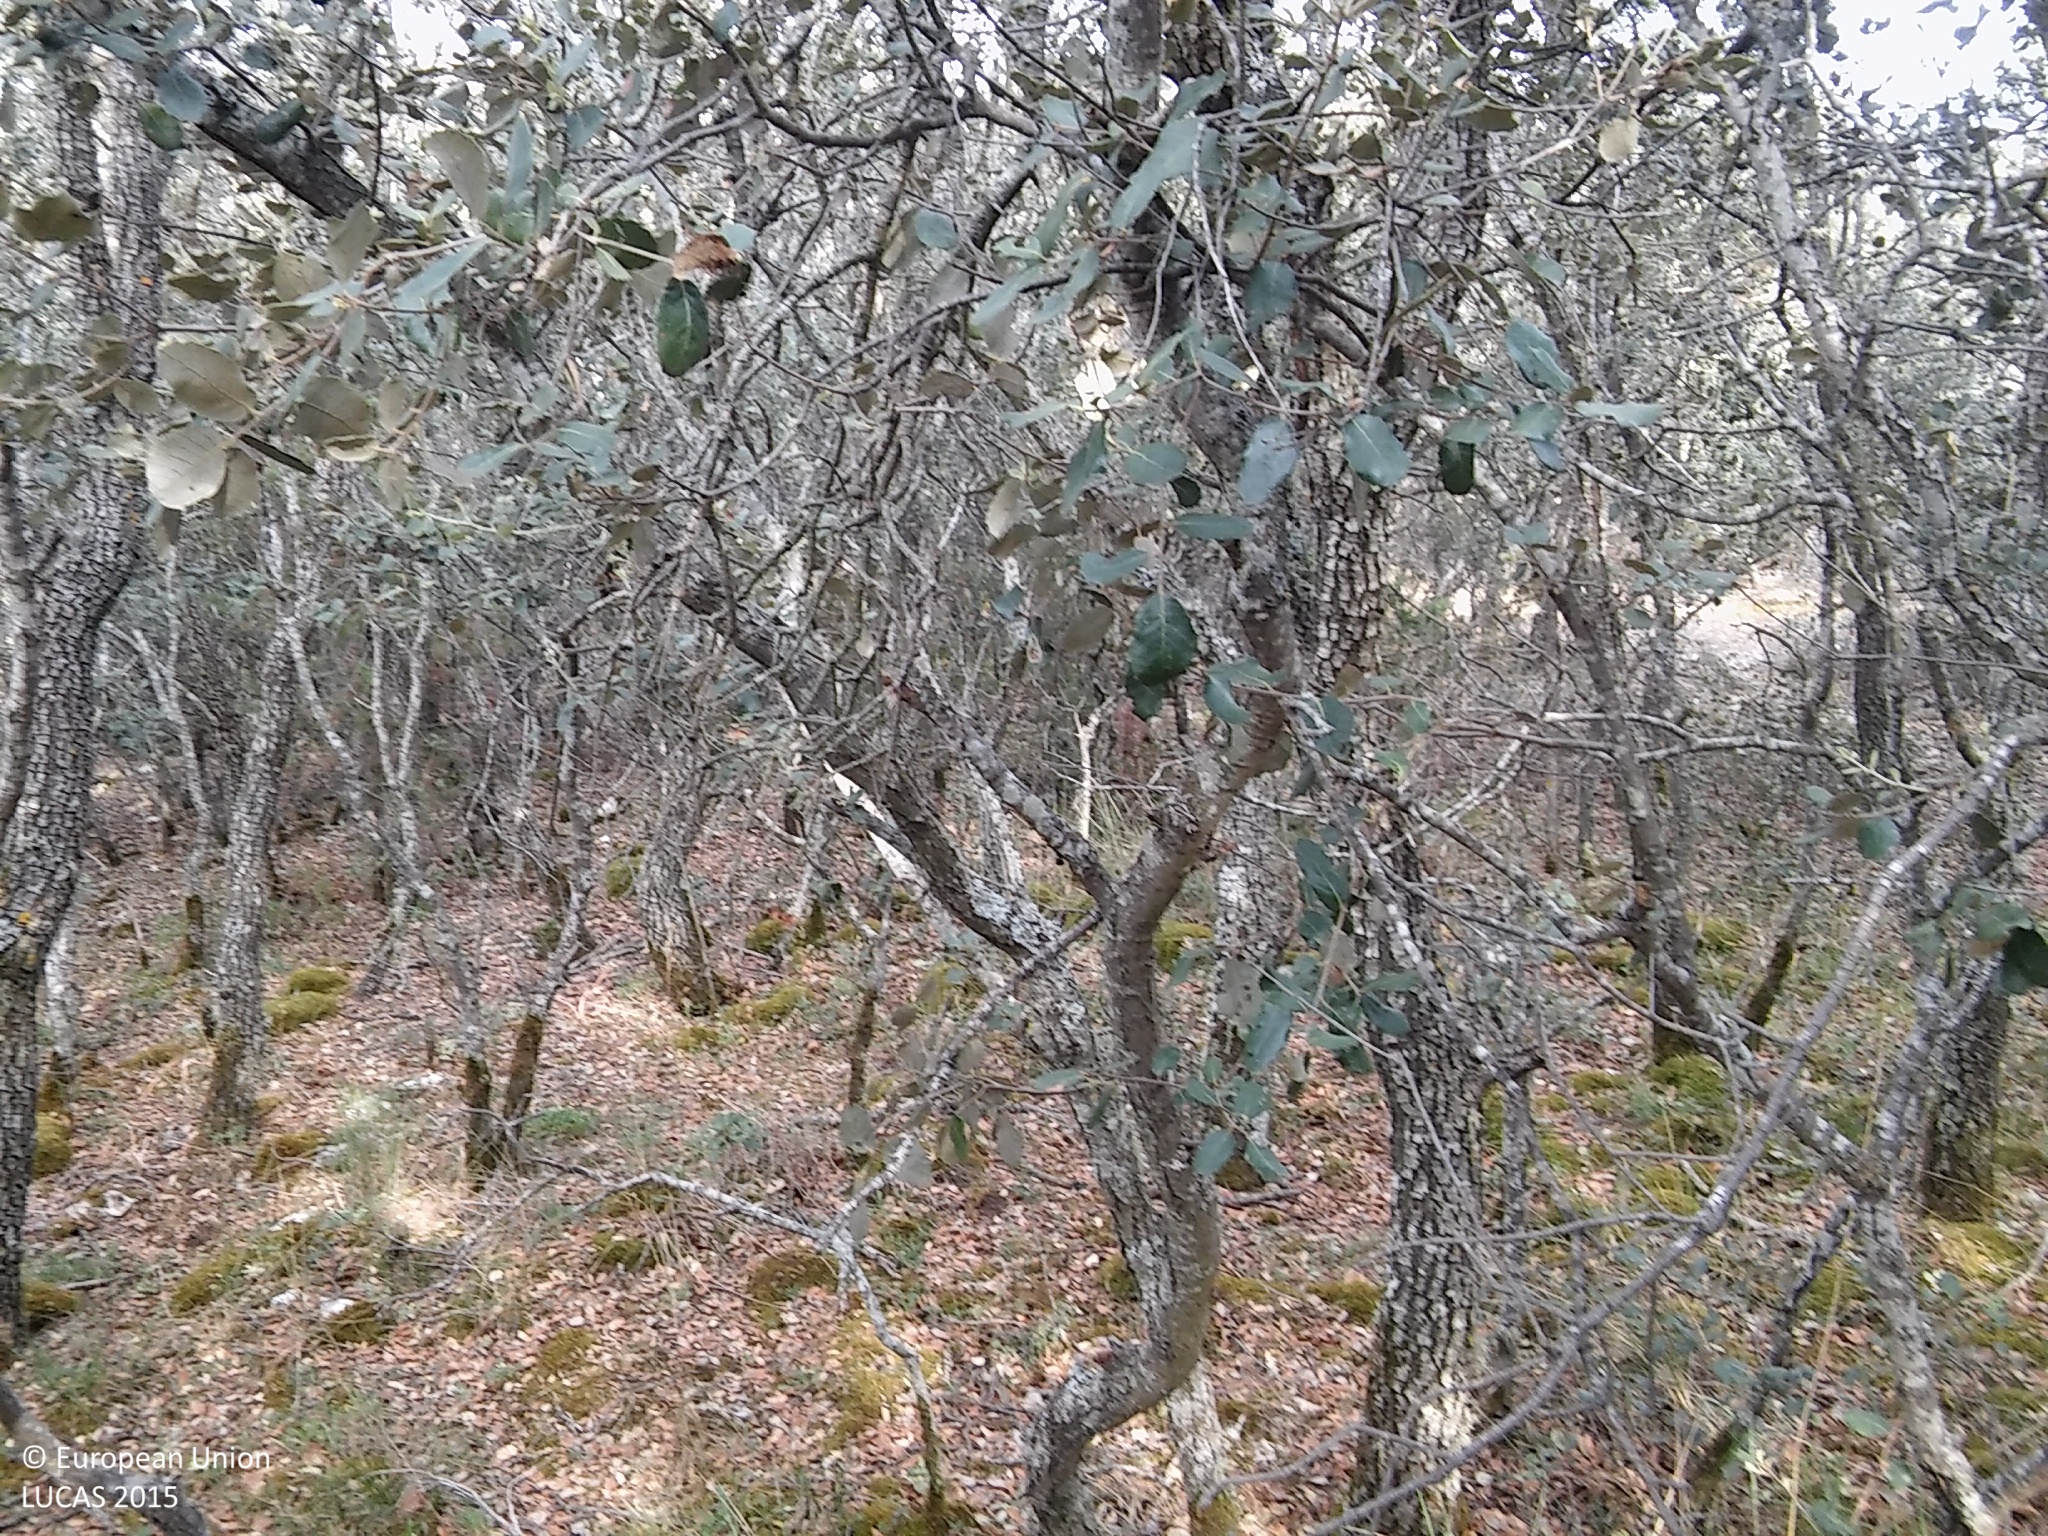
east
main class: Woodland
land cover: Broadleaved woodland
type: broadleaved evergreen forest
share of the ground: 50 - 75 %
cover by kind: broadleaved forest trees 70 %, unconsolidated bare surface 25 %, herbaceous plants 5 %
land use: Semi-natural and natural areas not in use
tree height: > 5 m
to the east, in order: Broadleaved woodland; Barley; Grass margins; Common wheat; Barley
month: July
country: ES
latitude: 41.5720
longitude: -3.5657
